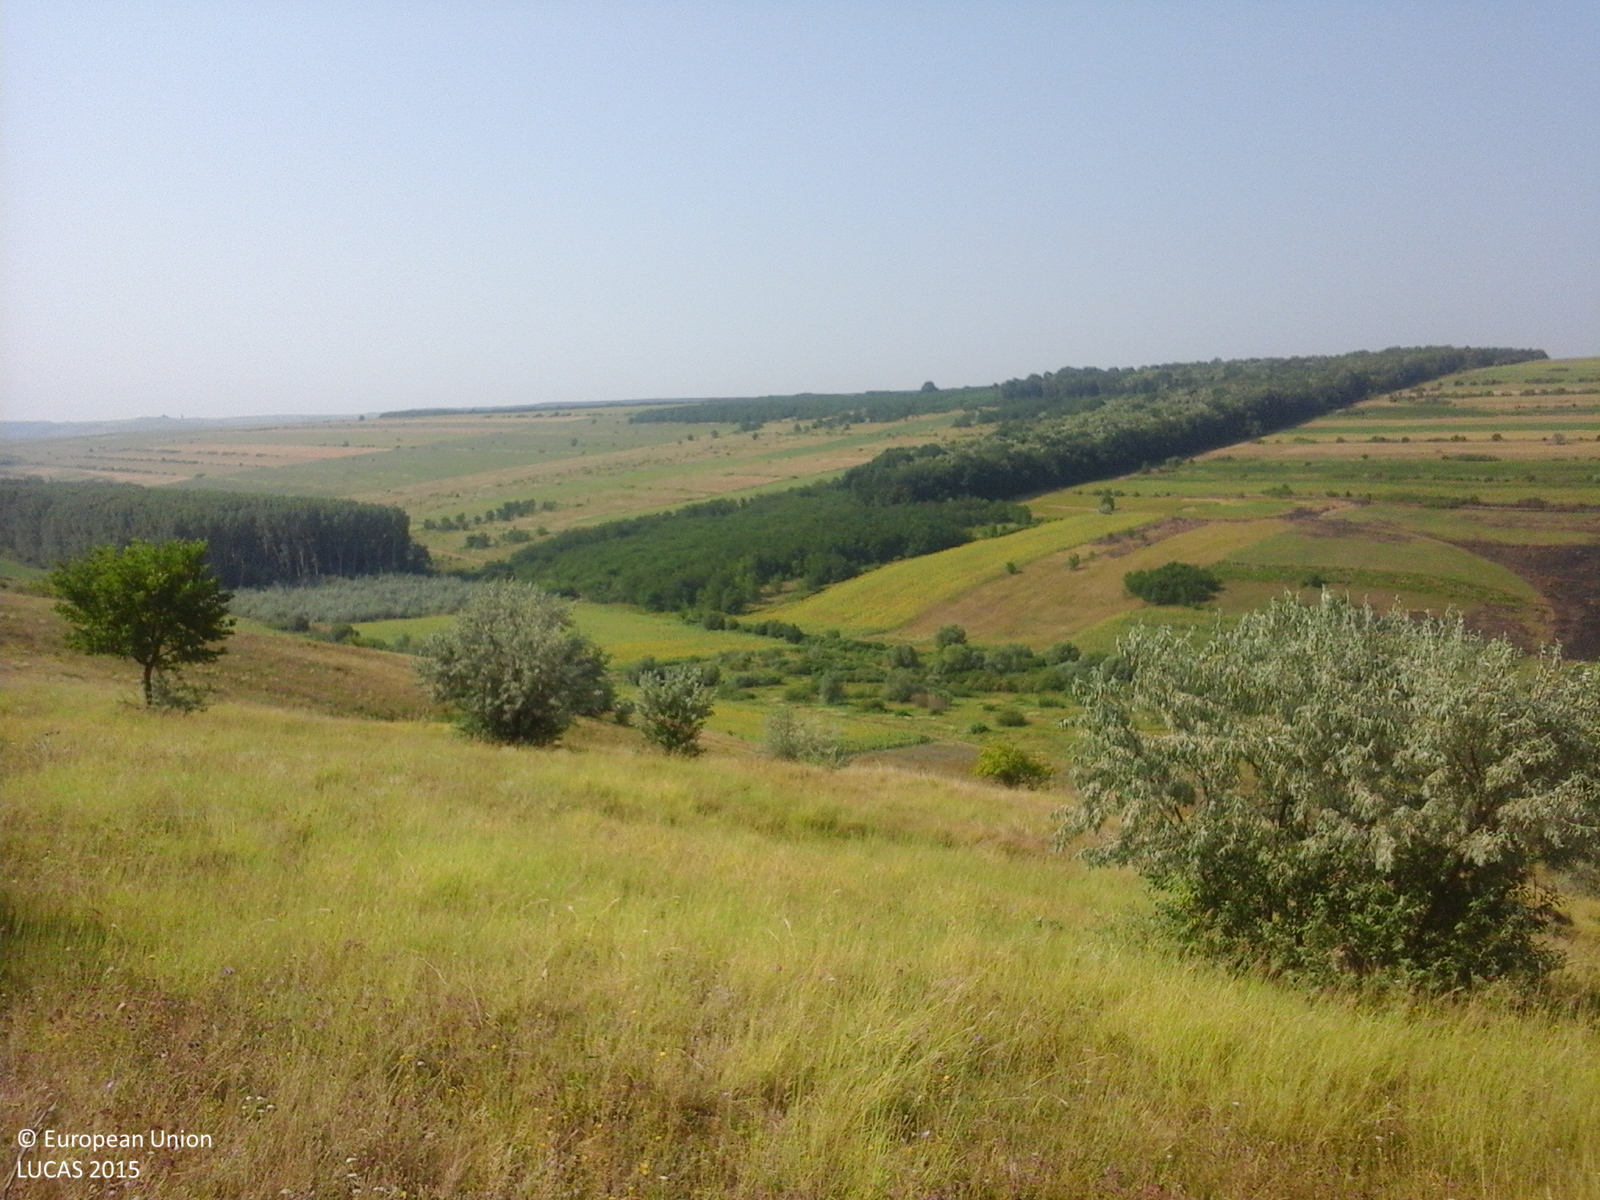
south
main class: Grassland
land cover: Grassland with sparse tree/shrub cover
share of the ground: > 75 %
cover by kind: herbaceous plants 95 %, broadleaved forest trees 5 %
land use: Agriculture (excluding fallow land and kitchen gardens)
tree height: > 5 m
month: July
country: RO
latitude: 46.4740
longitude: 27.6319
